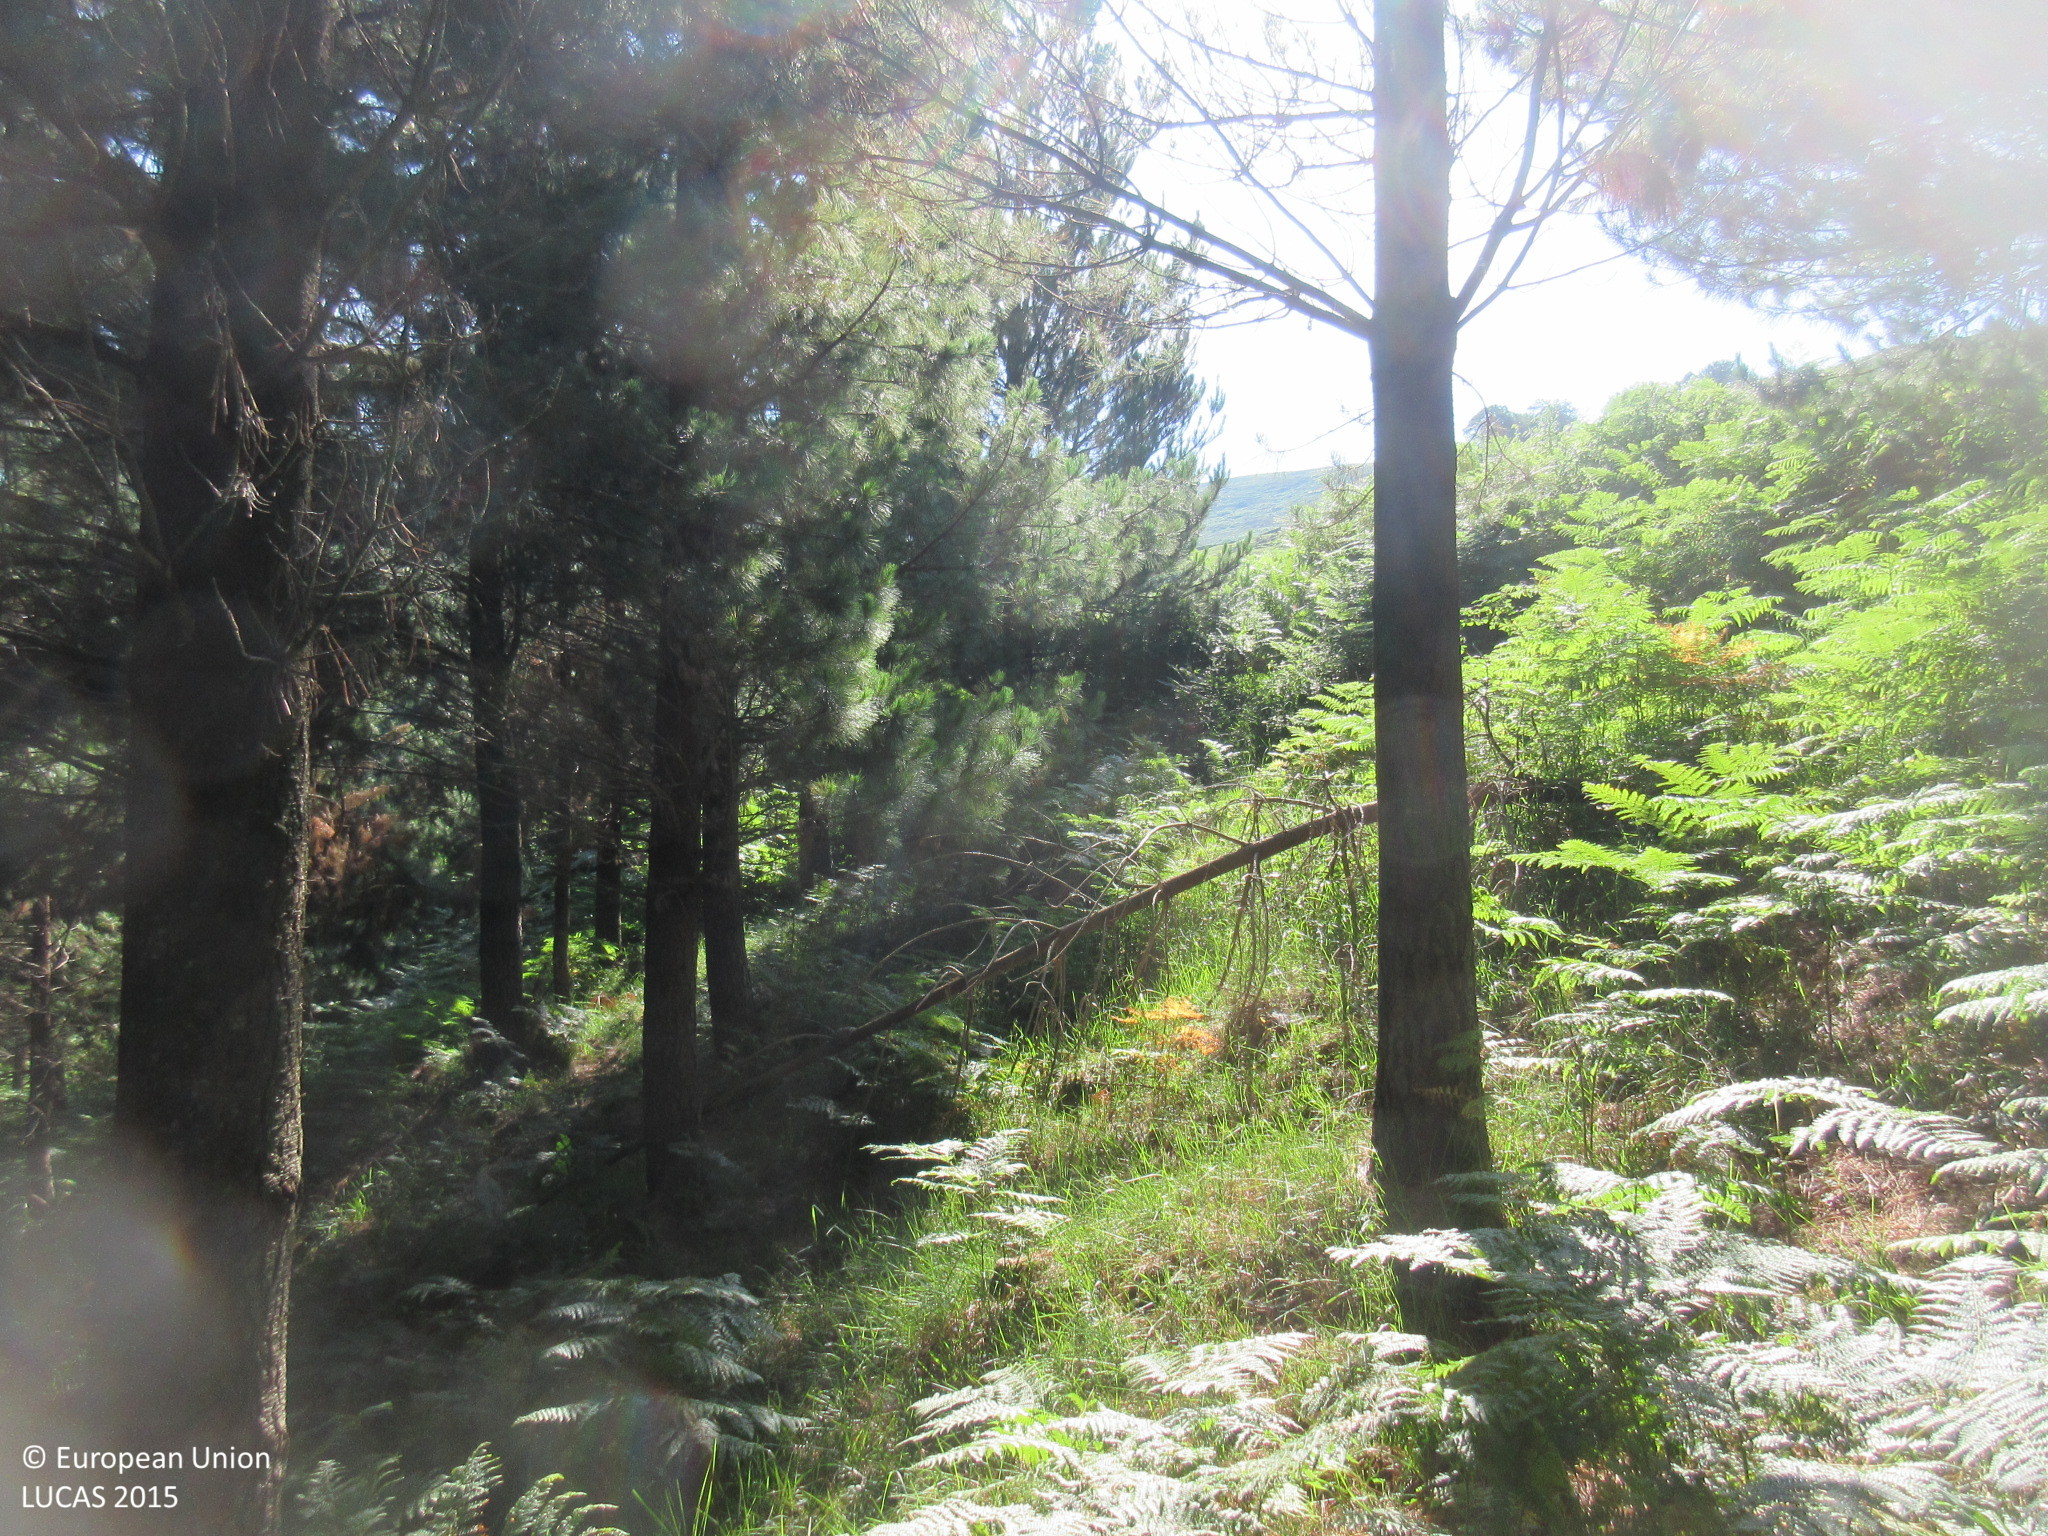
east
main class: Woodland
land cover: Pine dominated coniferous woodland
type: hemiboreal forest and nemoral coniferous forest and mixed broadleaved-coniferous forest
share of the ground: > 75 %
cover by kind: coniferous forest trees 90 %, shrubs 10 %
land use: Forestry
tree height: > 5 m
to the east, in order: Pine dominated coniferous woodland; Grass margins; Paved roads, cycling and walking lanes; Grass margins; Grassland without tree/shrub cover
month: July
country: ES
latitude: 43.0998
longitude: -3.8941
